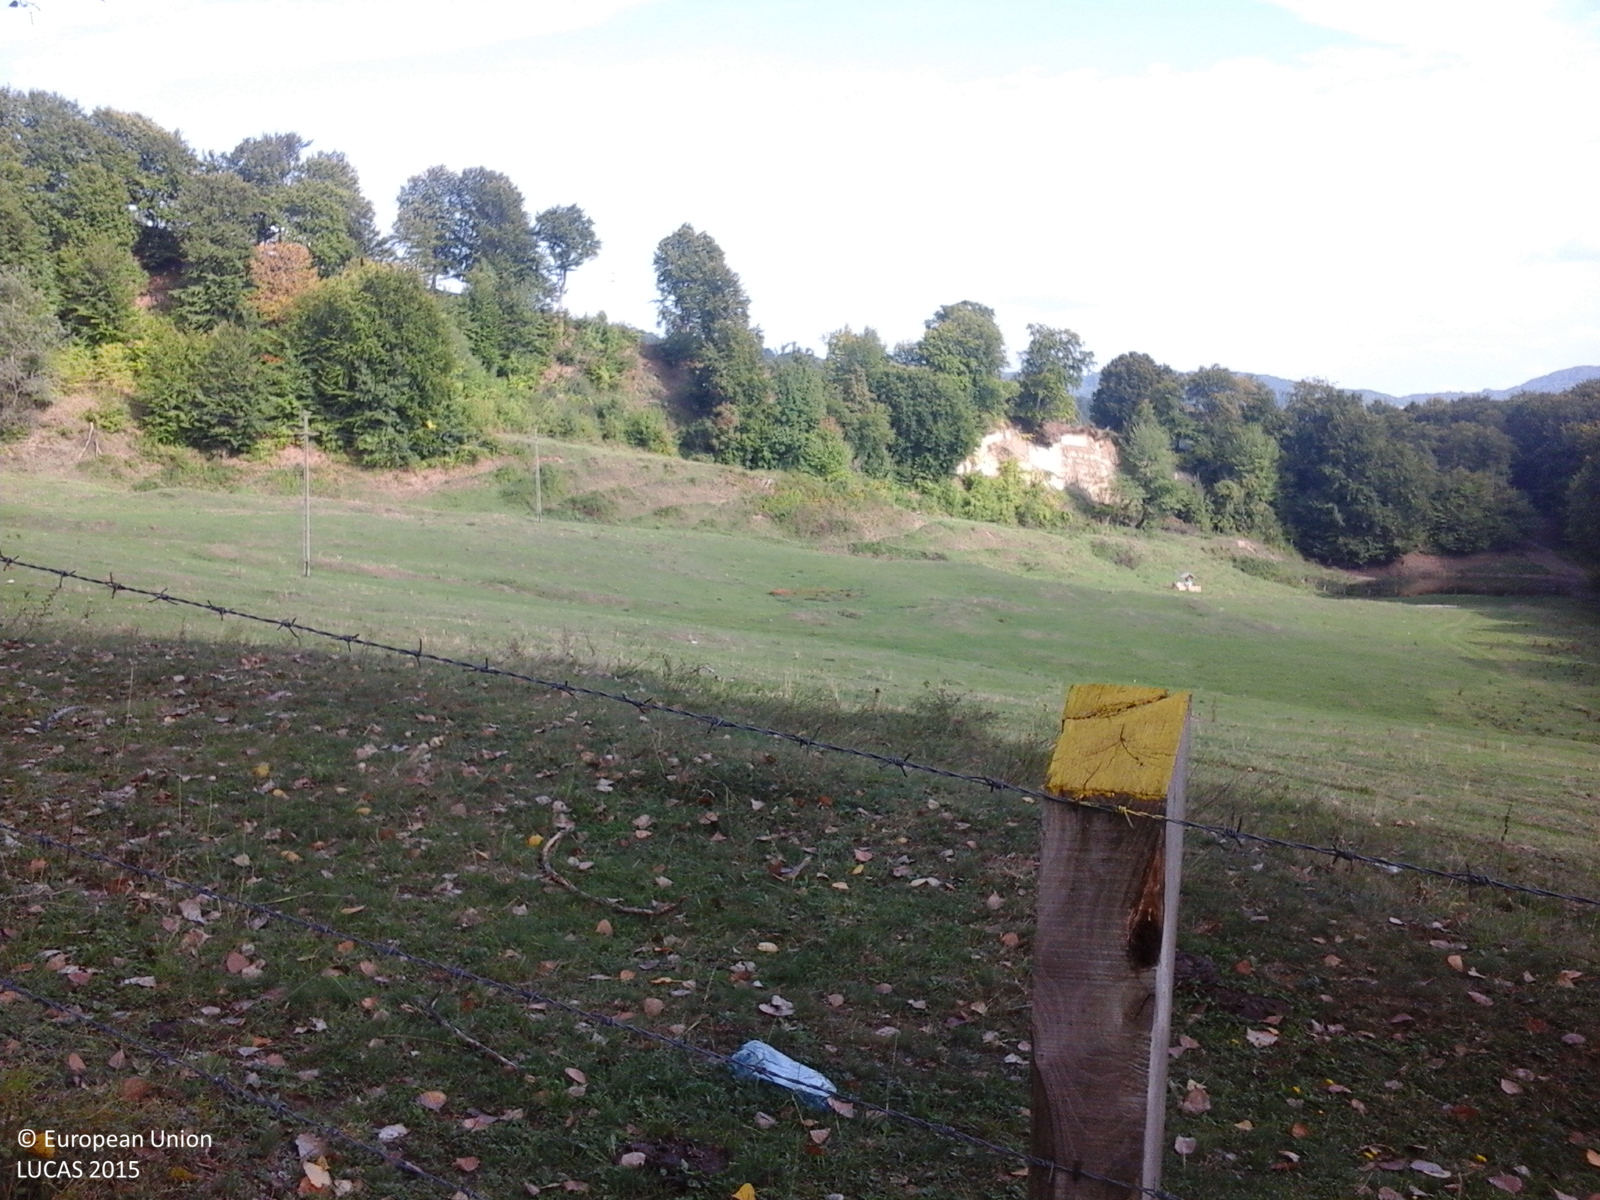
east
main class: Woodland
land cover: Broadleaved woodland
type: beech forest
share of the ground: > 75 %
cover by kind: broadleaved forest trees 100 %
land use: Forestry
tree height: > 5 m
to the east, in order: Broadleaved woodland; Fences; Broadleaved woodland; Grassland without tree/shrub cover; Tracks; Grassland without tree/shrub cover; Grassland with sparse tree/shrub cover; Rocks and stones; Fences; Spontaneously vegetated surfaces; Single bushes/trees; Grassland without tree/shrub cover
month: September
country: RO
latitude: 45.1675
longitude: 24.4139
